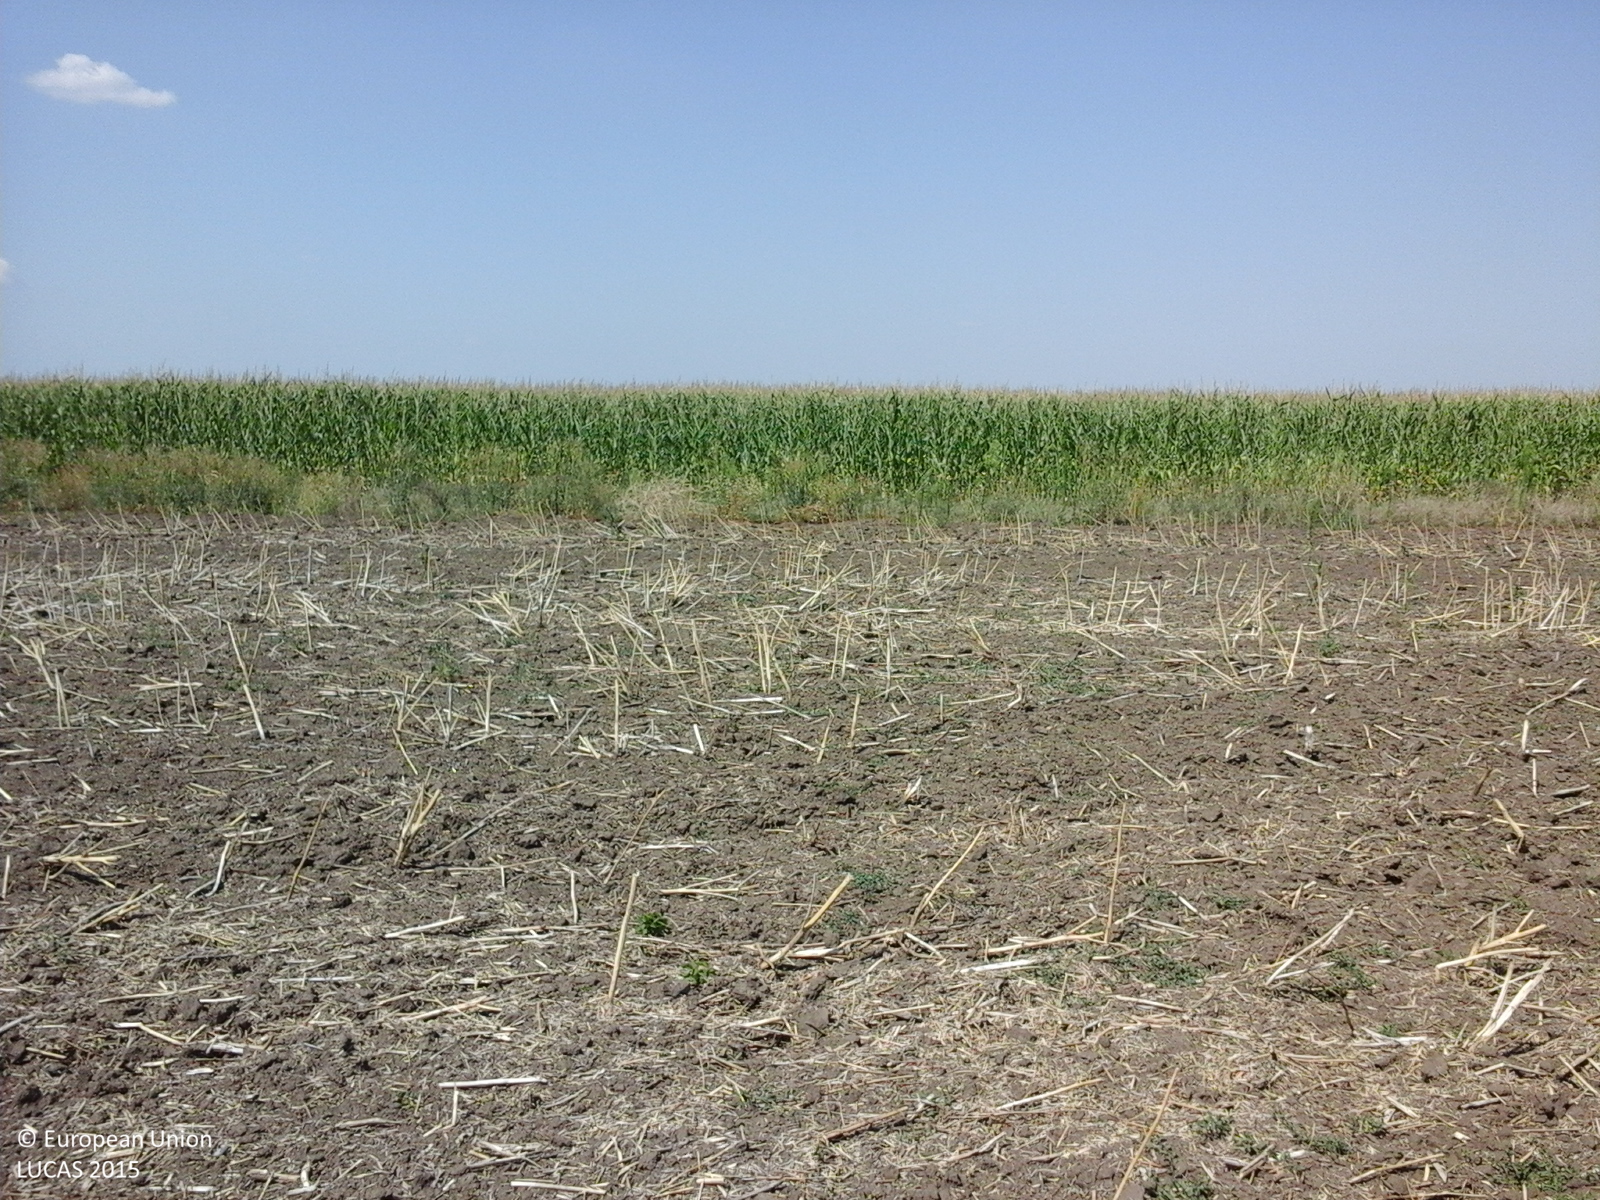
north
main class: Cropland
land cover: Rape and turnip rape
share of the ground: < 10 %
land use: Agriculture (excluding fallow land and kitchen gardens)
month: July
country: RO
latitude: 44.2860
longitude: 26.9547
